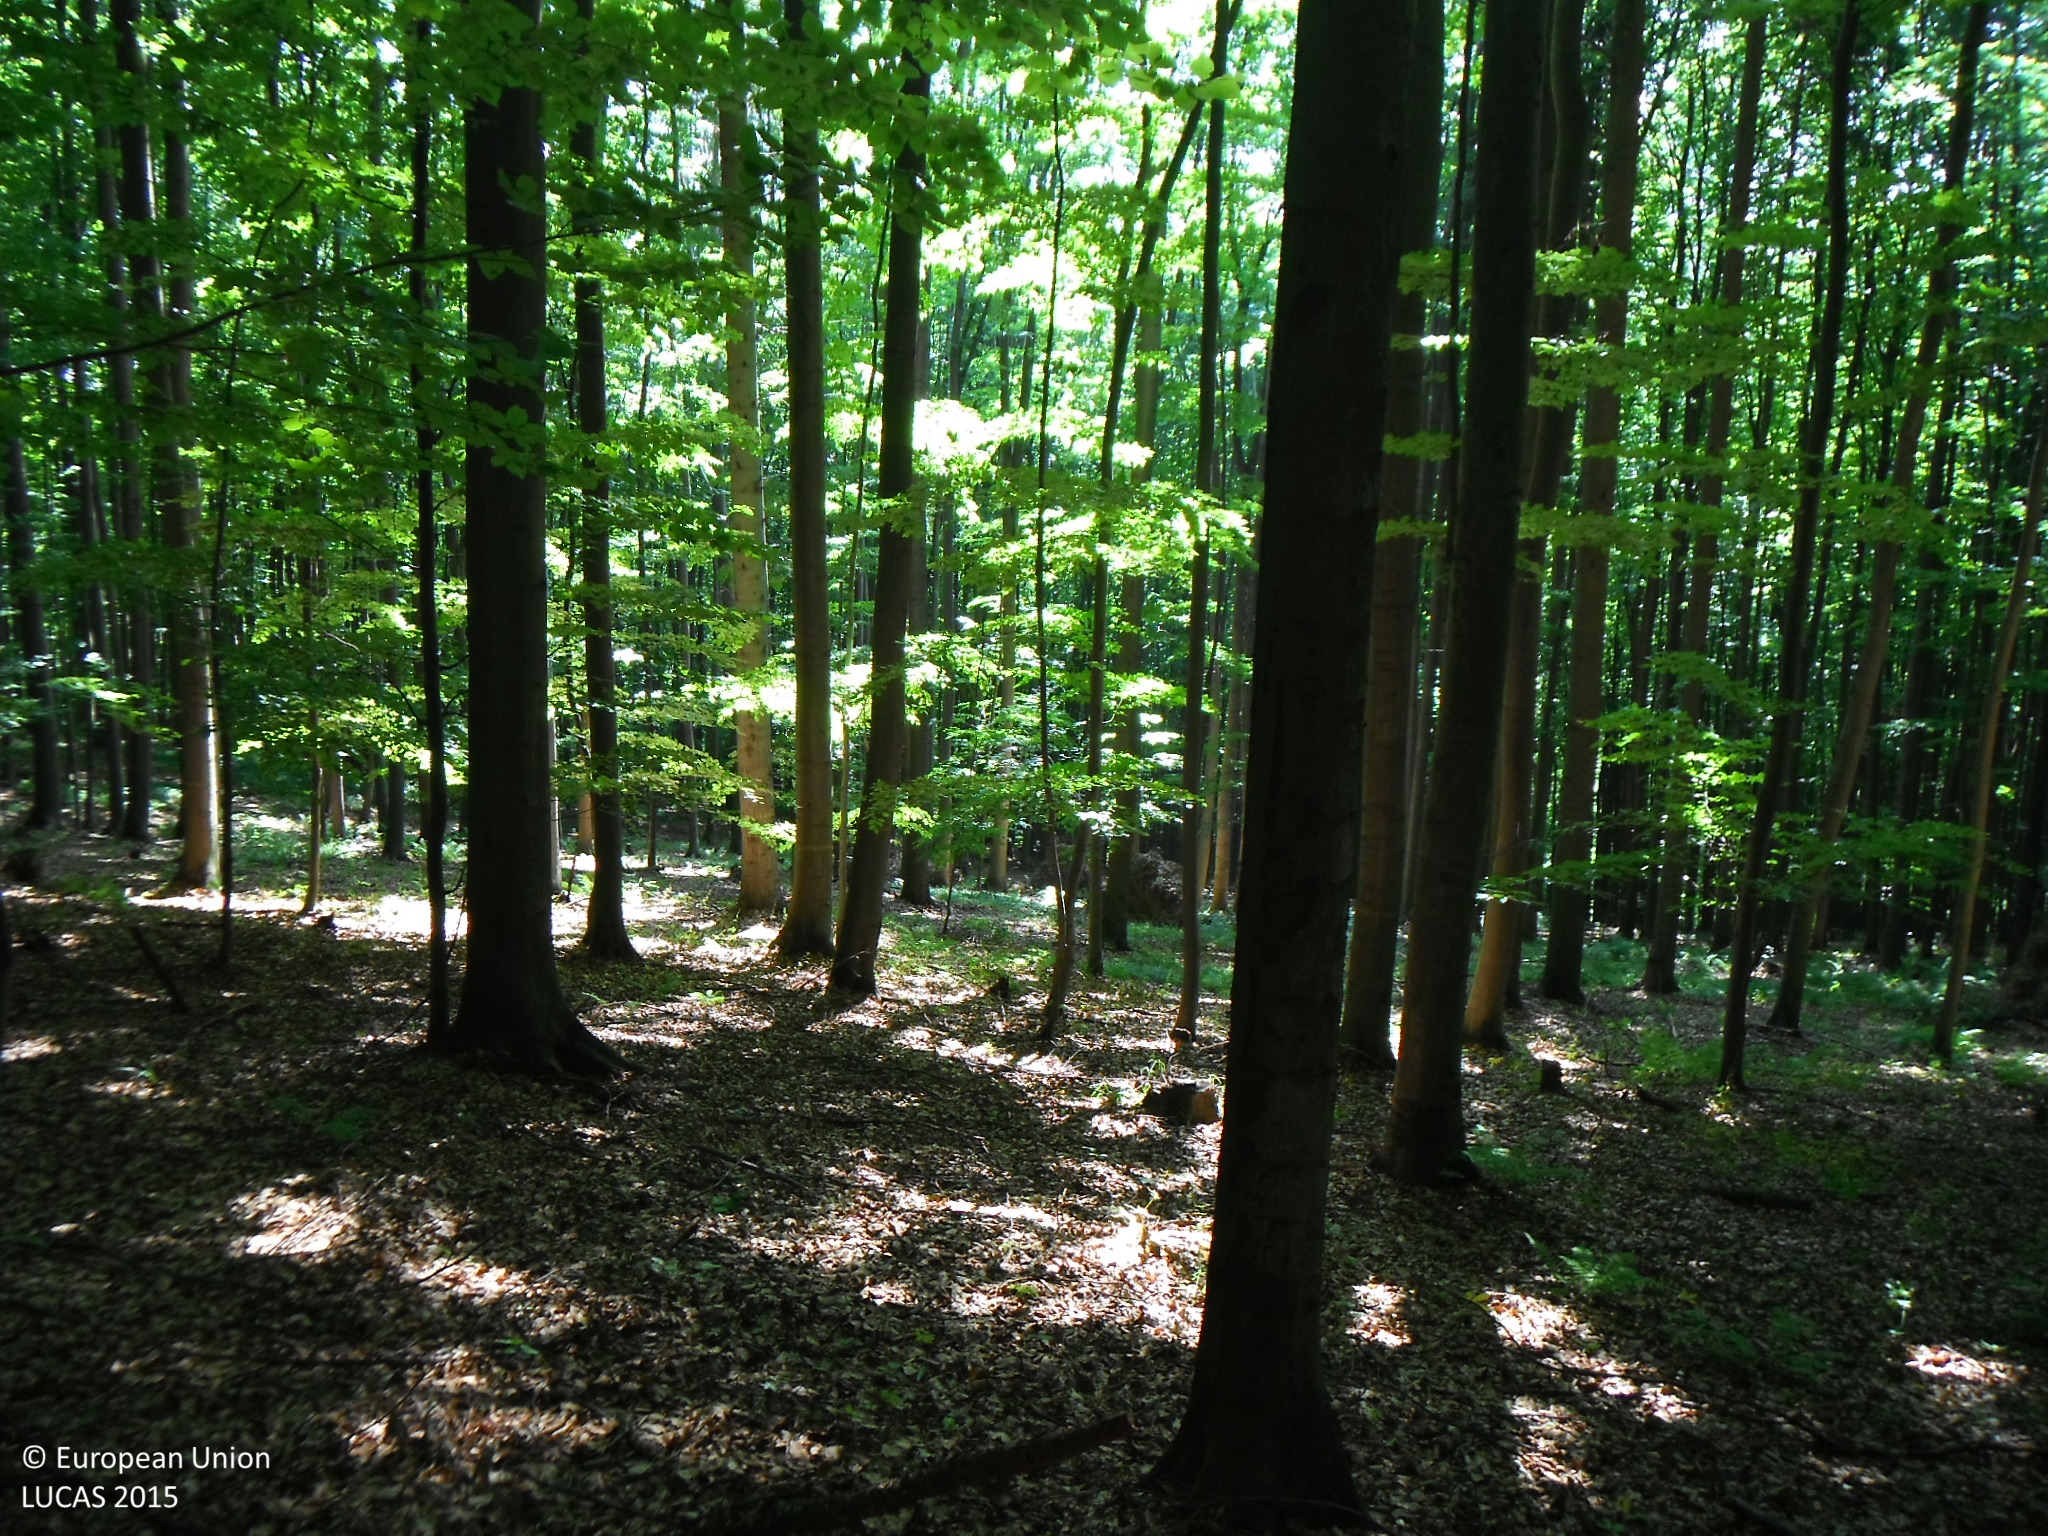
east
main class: Woodland
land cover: Broadleaved woodland
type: mesophytic deciduous forest
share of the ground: > 75 %
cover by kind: broadleaved forest trees 80 %, coniferous forest trees 20 %
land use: Forestry
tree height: > 5 m
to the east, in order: Broadleaved woodland; Tracks; Broadleaved woodland
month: July
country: SK
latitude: 49.2628
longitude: 21.2449
